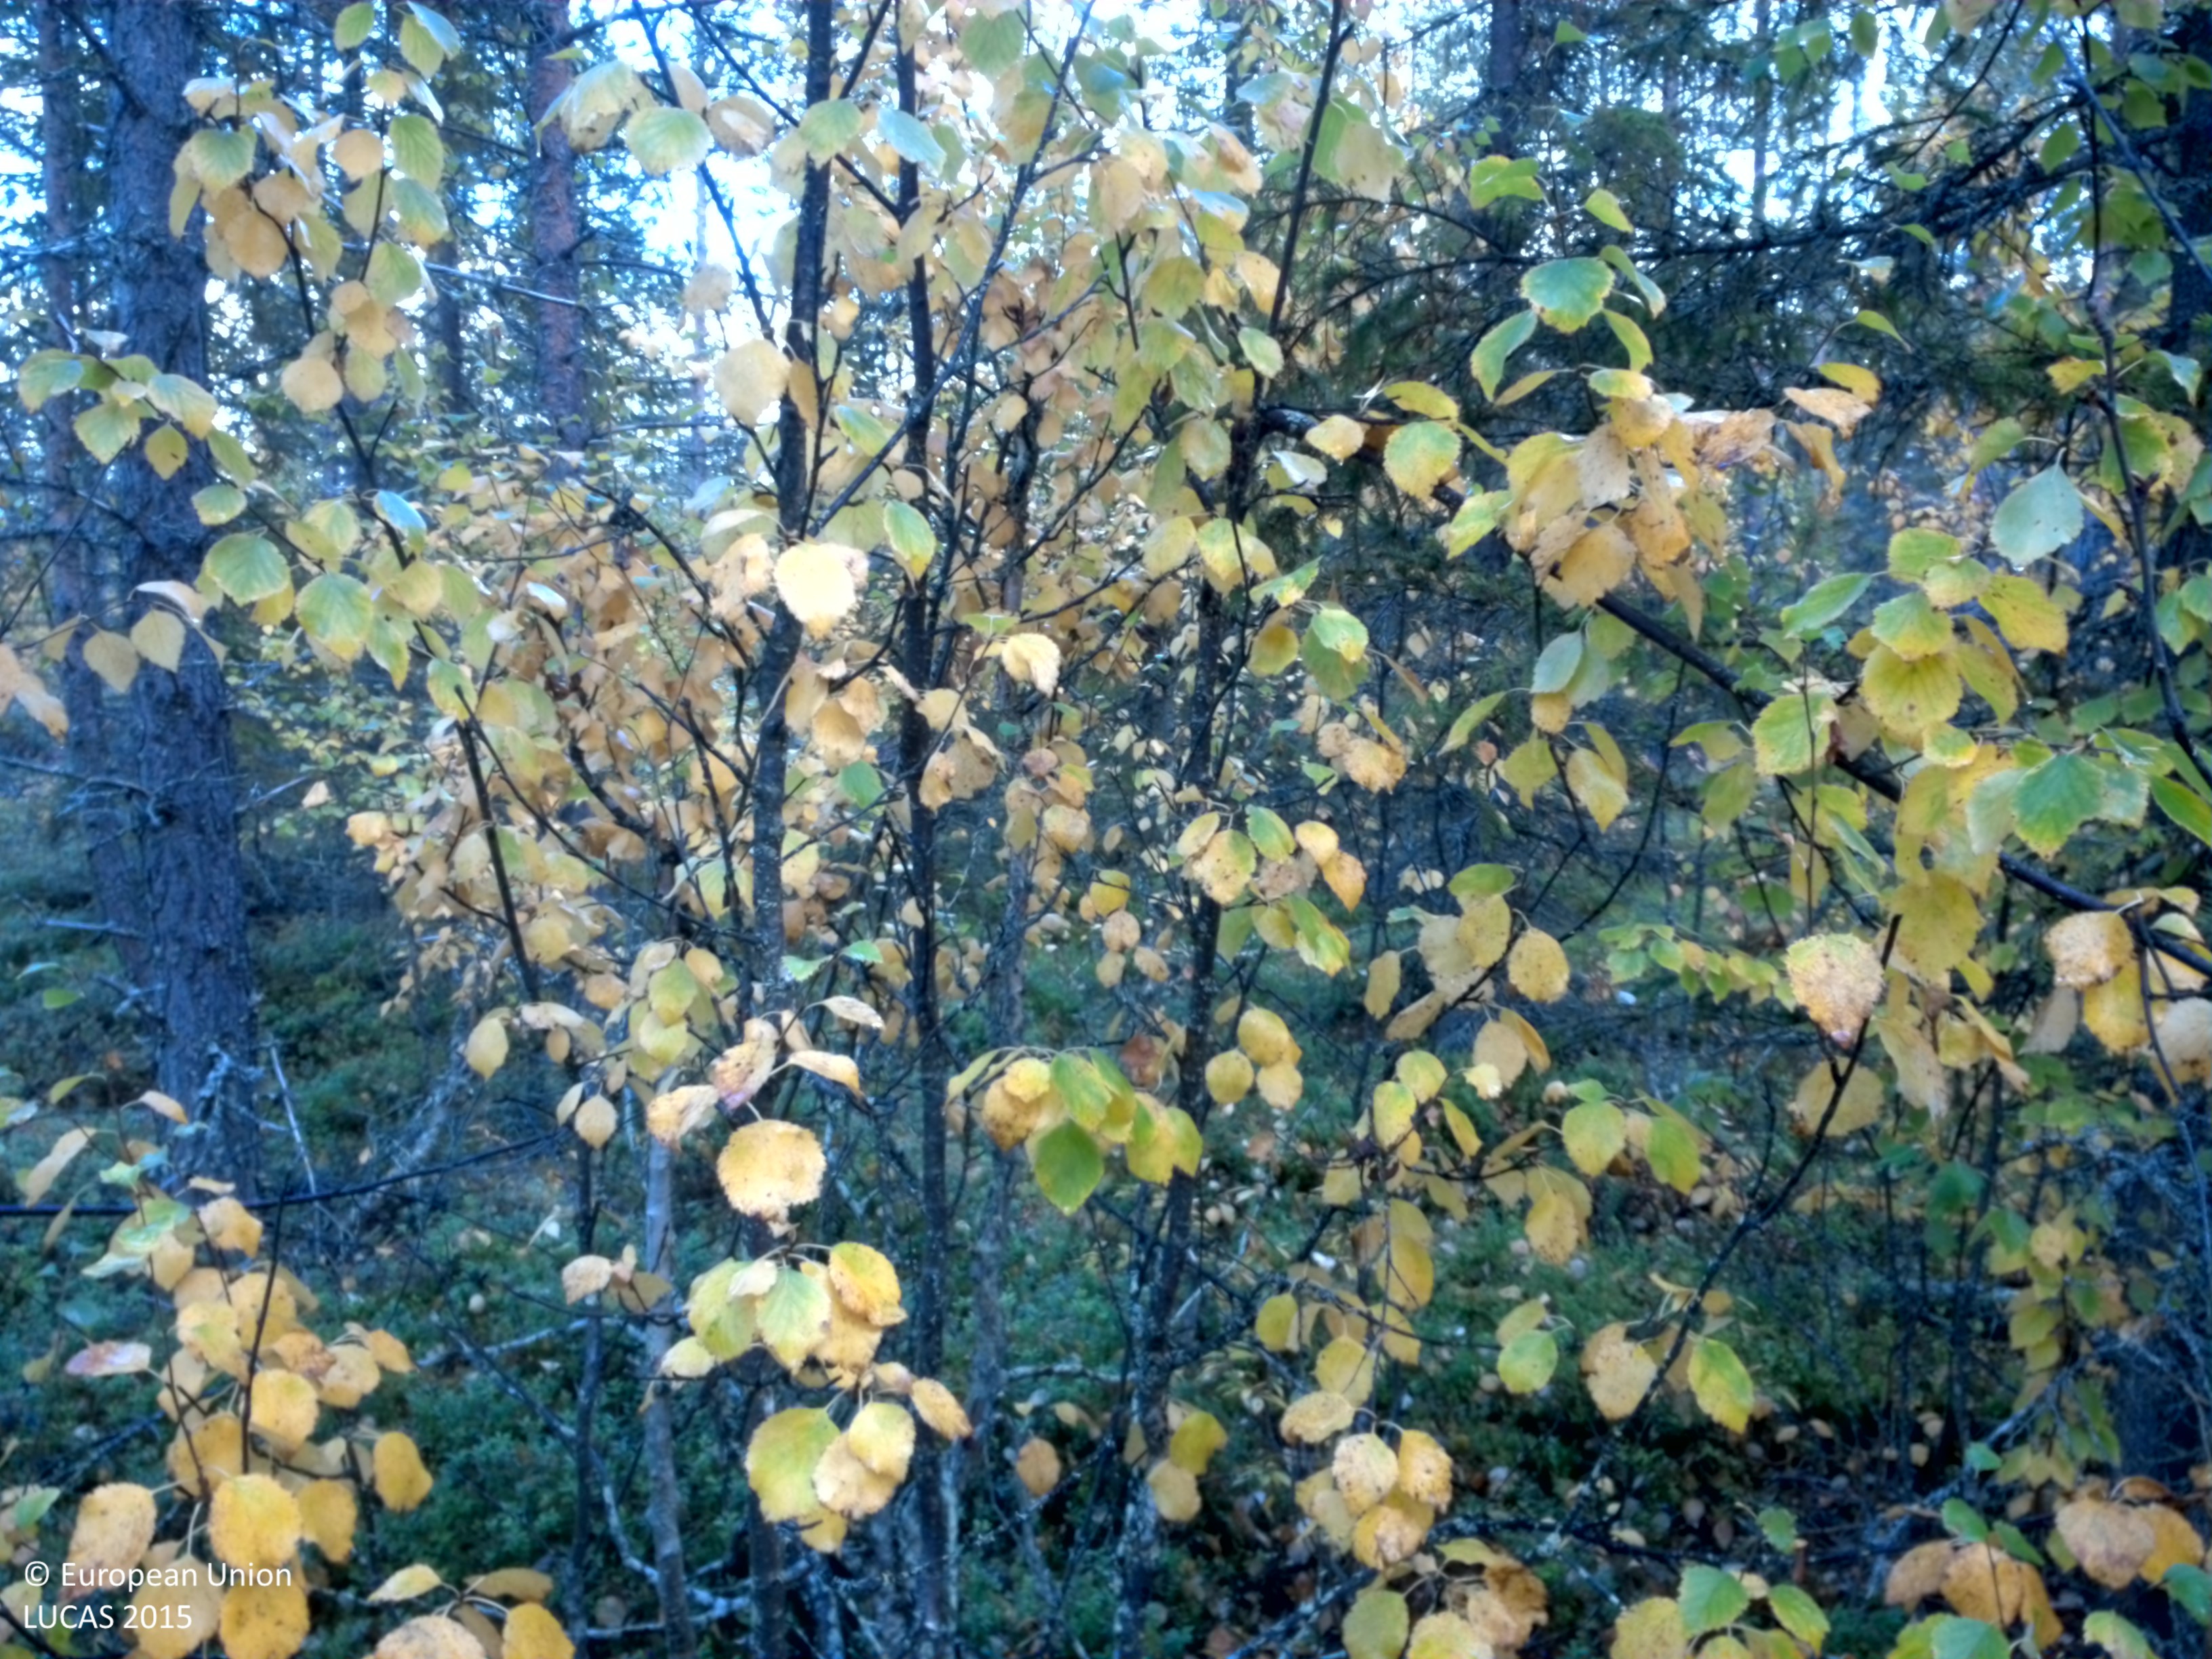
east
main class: Woodland
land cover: Pine dominated mixed woodland
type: boreal forest
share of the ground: 25 - 50 %
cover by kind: shrubs 35 %, coniferous forest trees 25 %, lichens and mosses 15 %, broadleaved forest trees 10 %, herbaceous plants 10 %
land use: Forestry
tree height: > 5 m
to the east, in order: Pine dominated mixed woodland; Tracks; Pine dominated mixed woodland; Spruce dominated mixed woodland; Shrubland with sparse tree cover; Peatbogs; Shrubland with sparse tree cover; Other coniferous woodland; Pine dominated mixed woodland
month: September
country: SE
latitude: 65.2232
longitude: 16.5711
